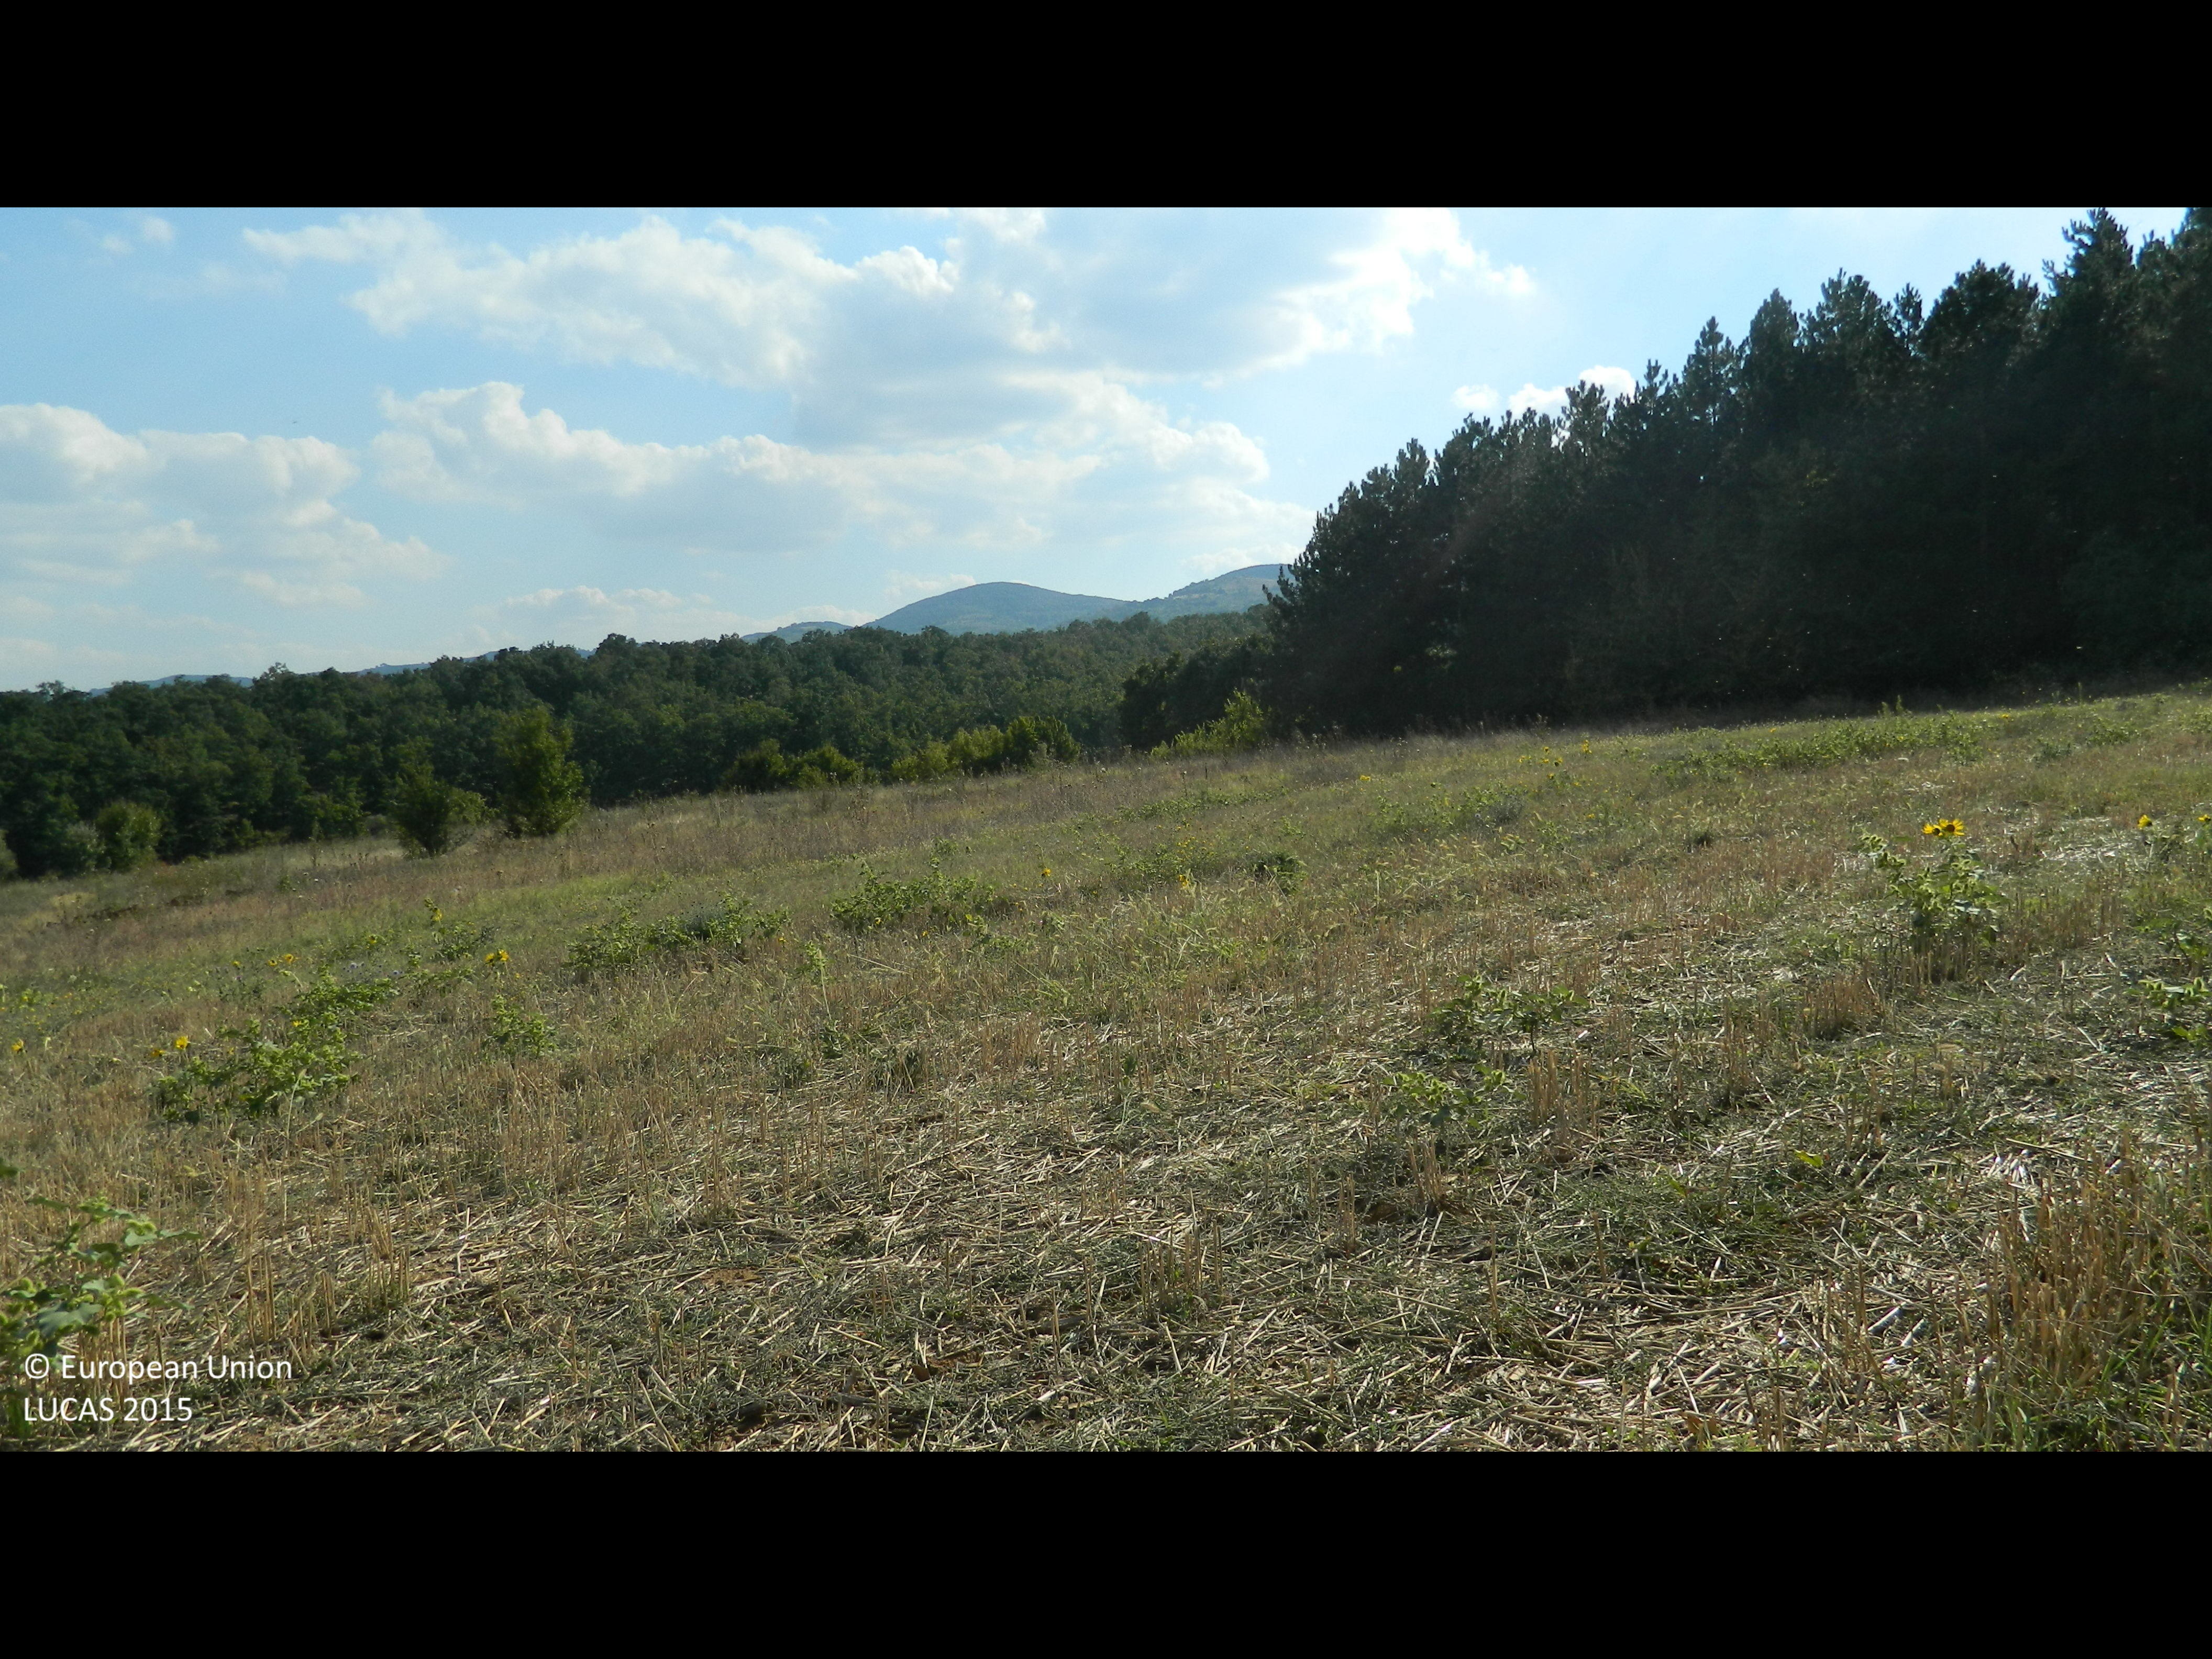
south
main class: Cropland
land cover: Common wheat
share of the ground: < 10 %
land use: Agriculture (excluding fallow land and kitchen gardens)
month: September
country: BG
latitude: 41.7544
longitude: 25.5645
